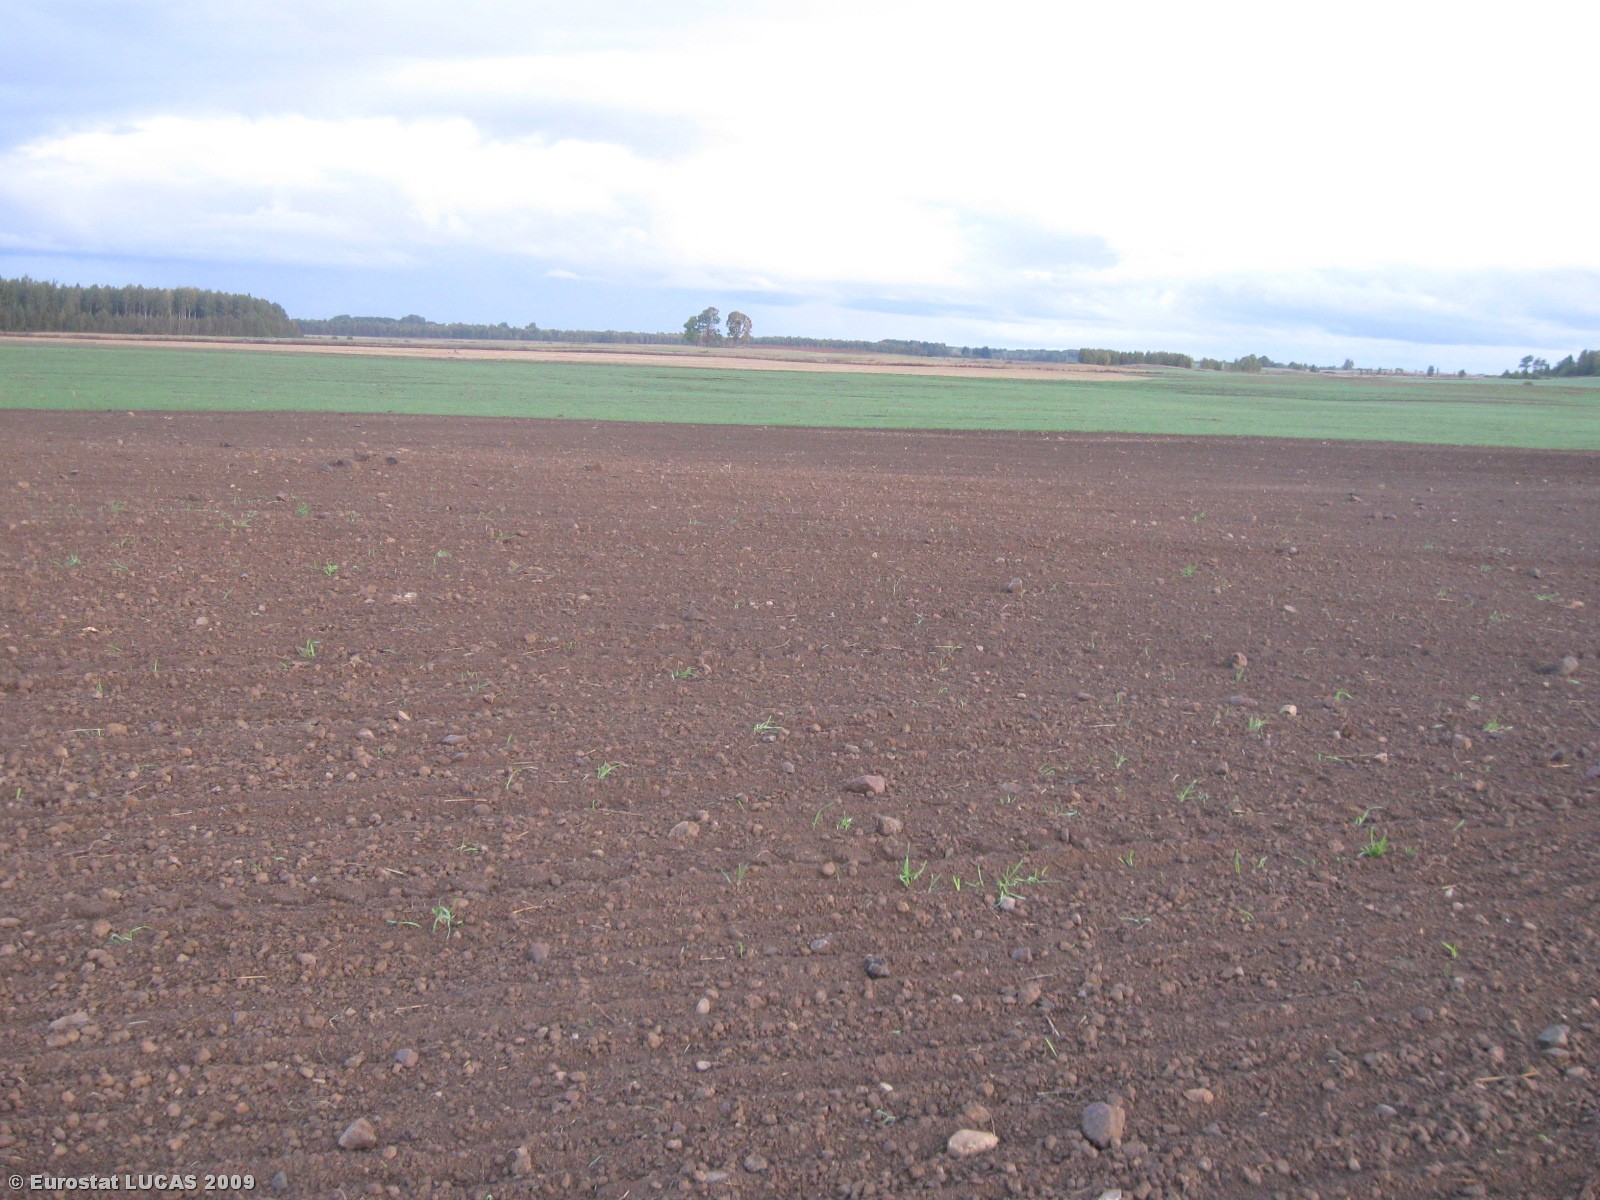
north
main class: Cropland
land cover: Rye
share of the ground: < 10 %
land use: Agriculture (excluding fallow land and kitchen gardens)
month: September
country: LT
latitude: 56.1685
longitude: 25.2375
